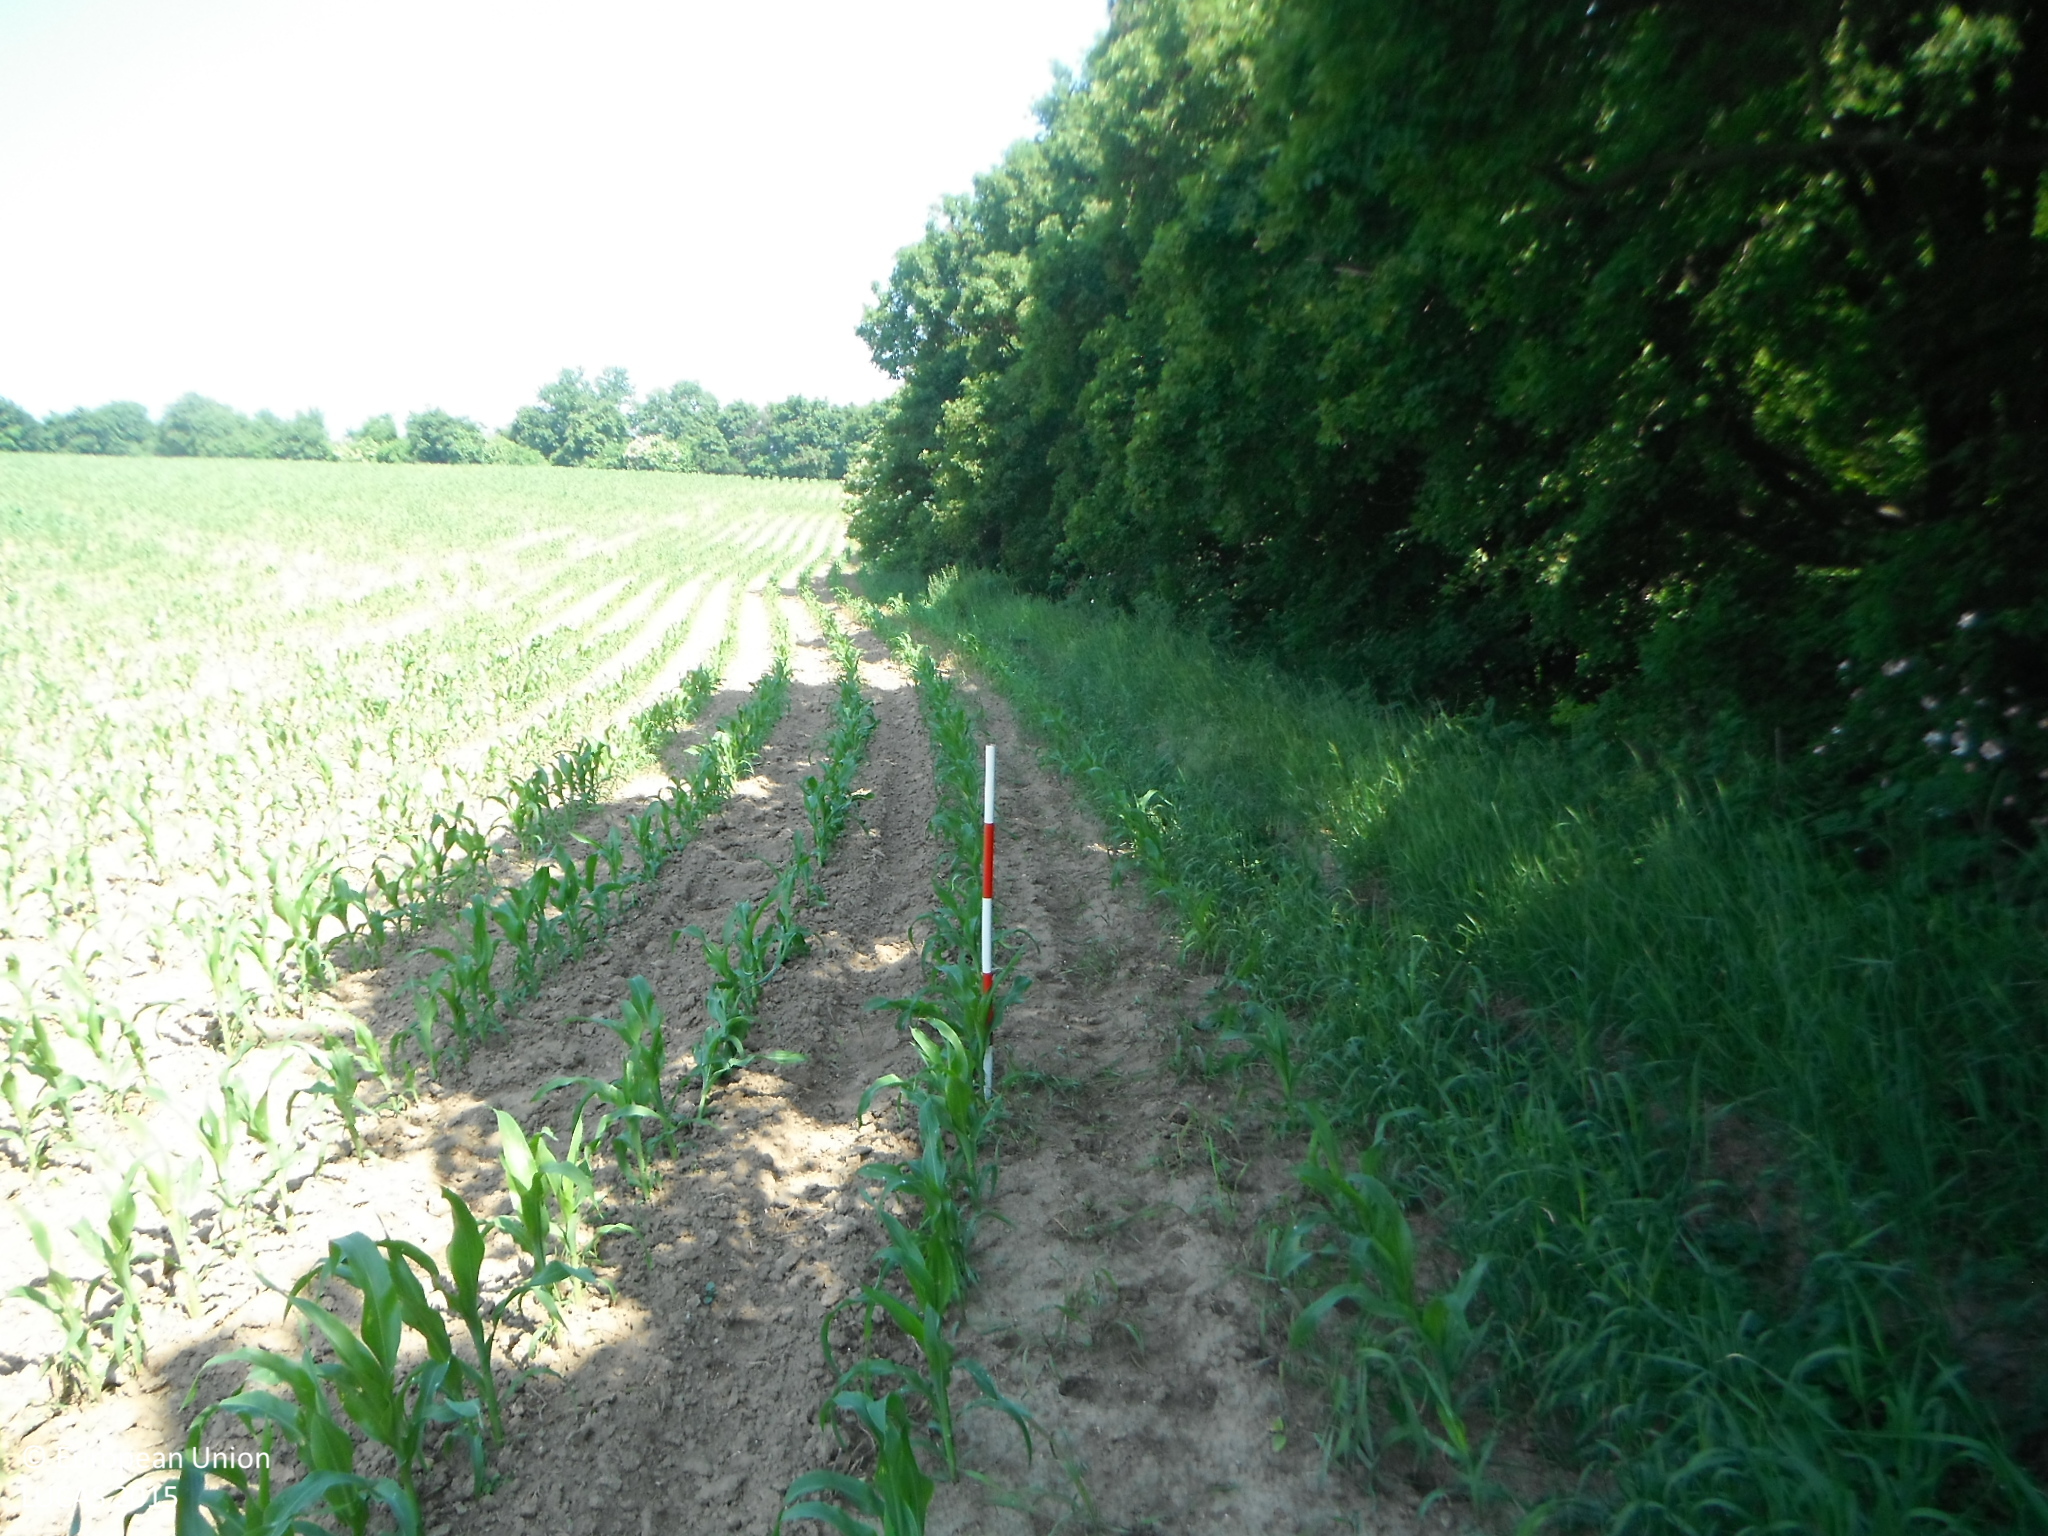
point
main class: Cropland
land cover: Maize
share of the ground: 25 - 50 %
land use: Agriculture (excluding fallow land and kitchen gardens)
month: June
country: SK
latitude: 48.2849
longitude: 17.3543
